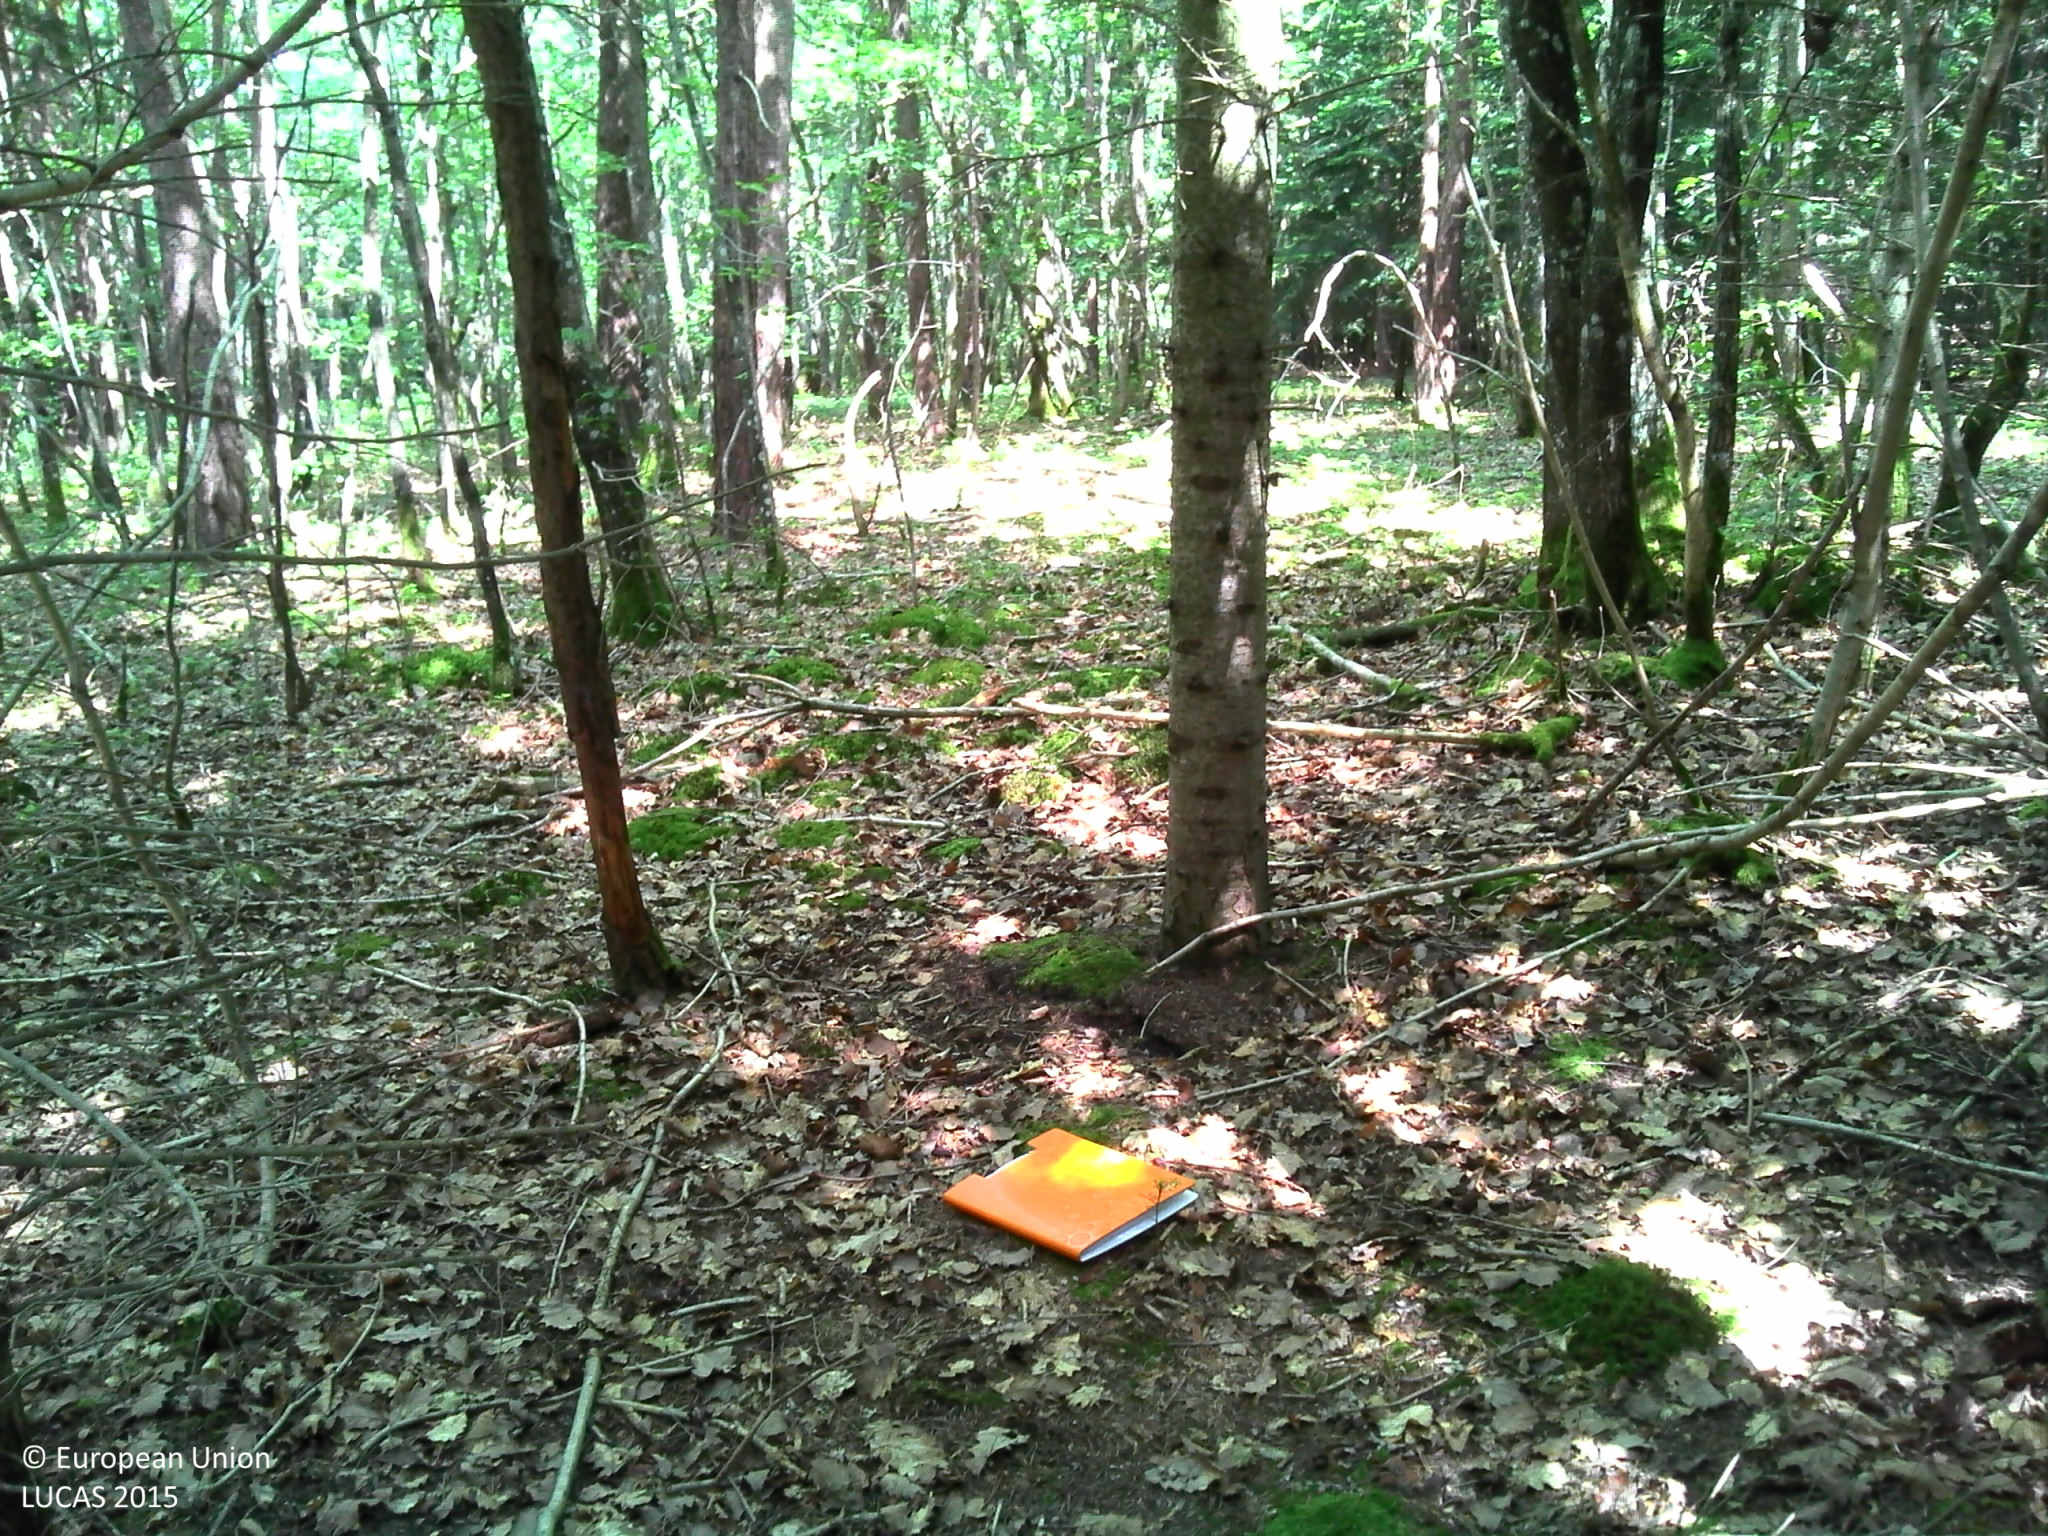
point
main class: Woodland
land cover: Spruce dominated mixed woodland
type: acidophilous oak and oak-birch forest
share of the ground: > 75 %
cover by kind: broadleaved forest trees 70 %, coniferous forest trees 25 %, lichens and mosses 5 %
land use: Forestry
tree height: > 5 m
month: June
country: FR
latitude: 46.1429
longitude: 3.0465
